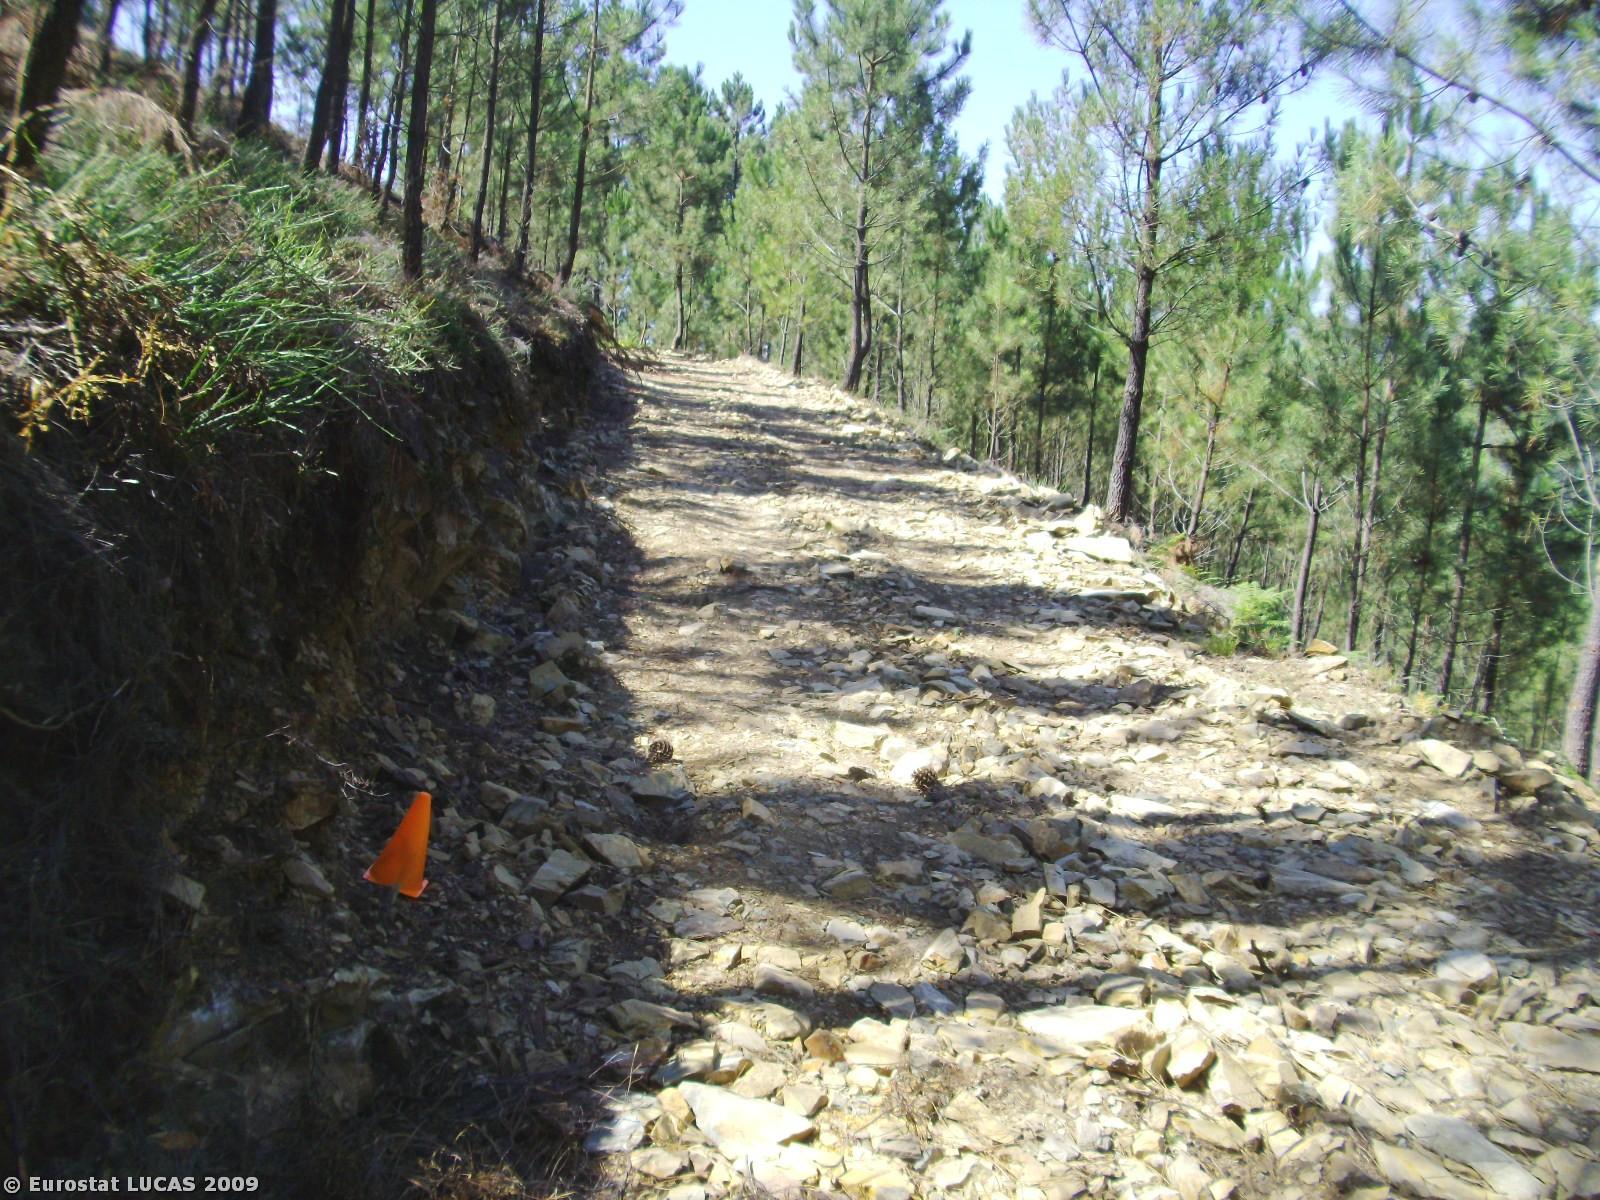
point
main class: Woodland
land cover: Coniferous woodland
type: coniferous forest of the mediterranean region
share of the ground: > 75 %
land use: Forestry
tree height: > 5 m
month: August
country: PT
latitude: 41.3517
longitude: -7.9334
